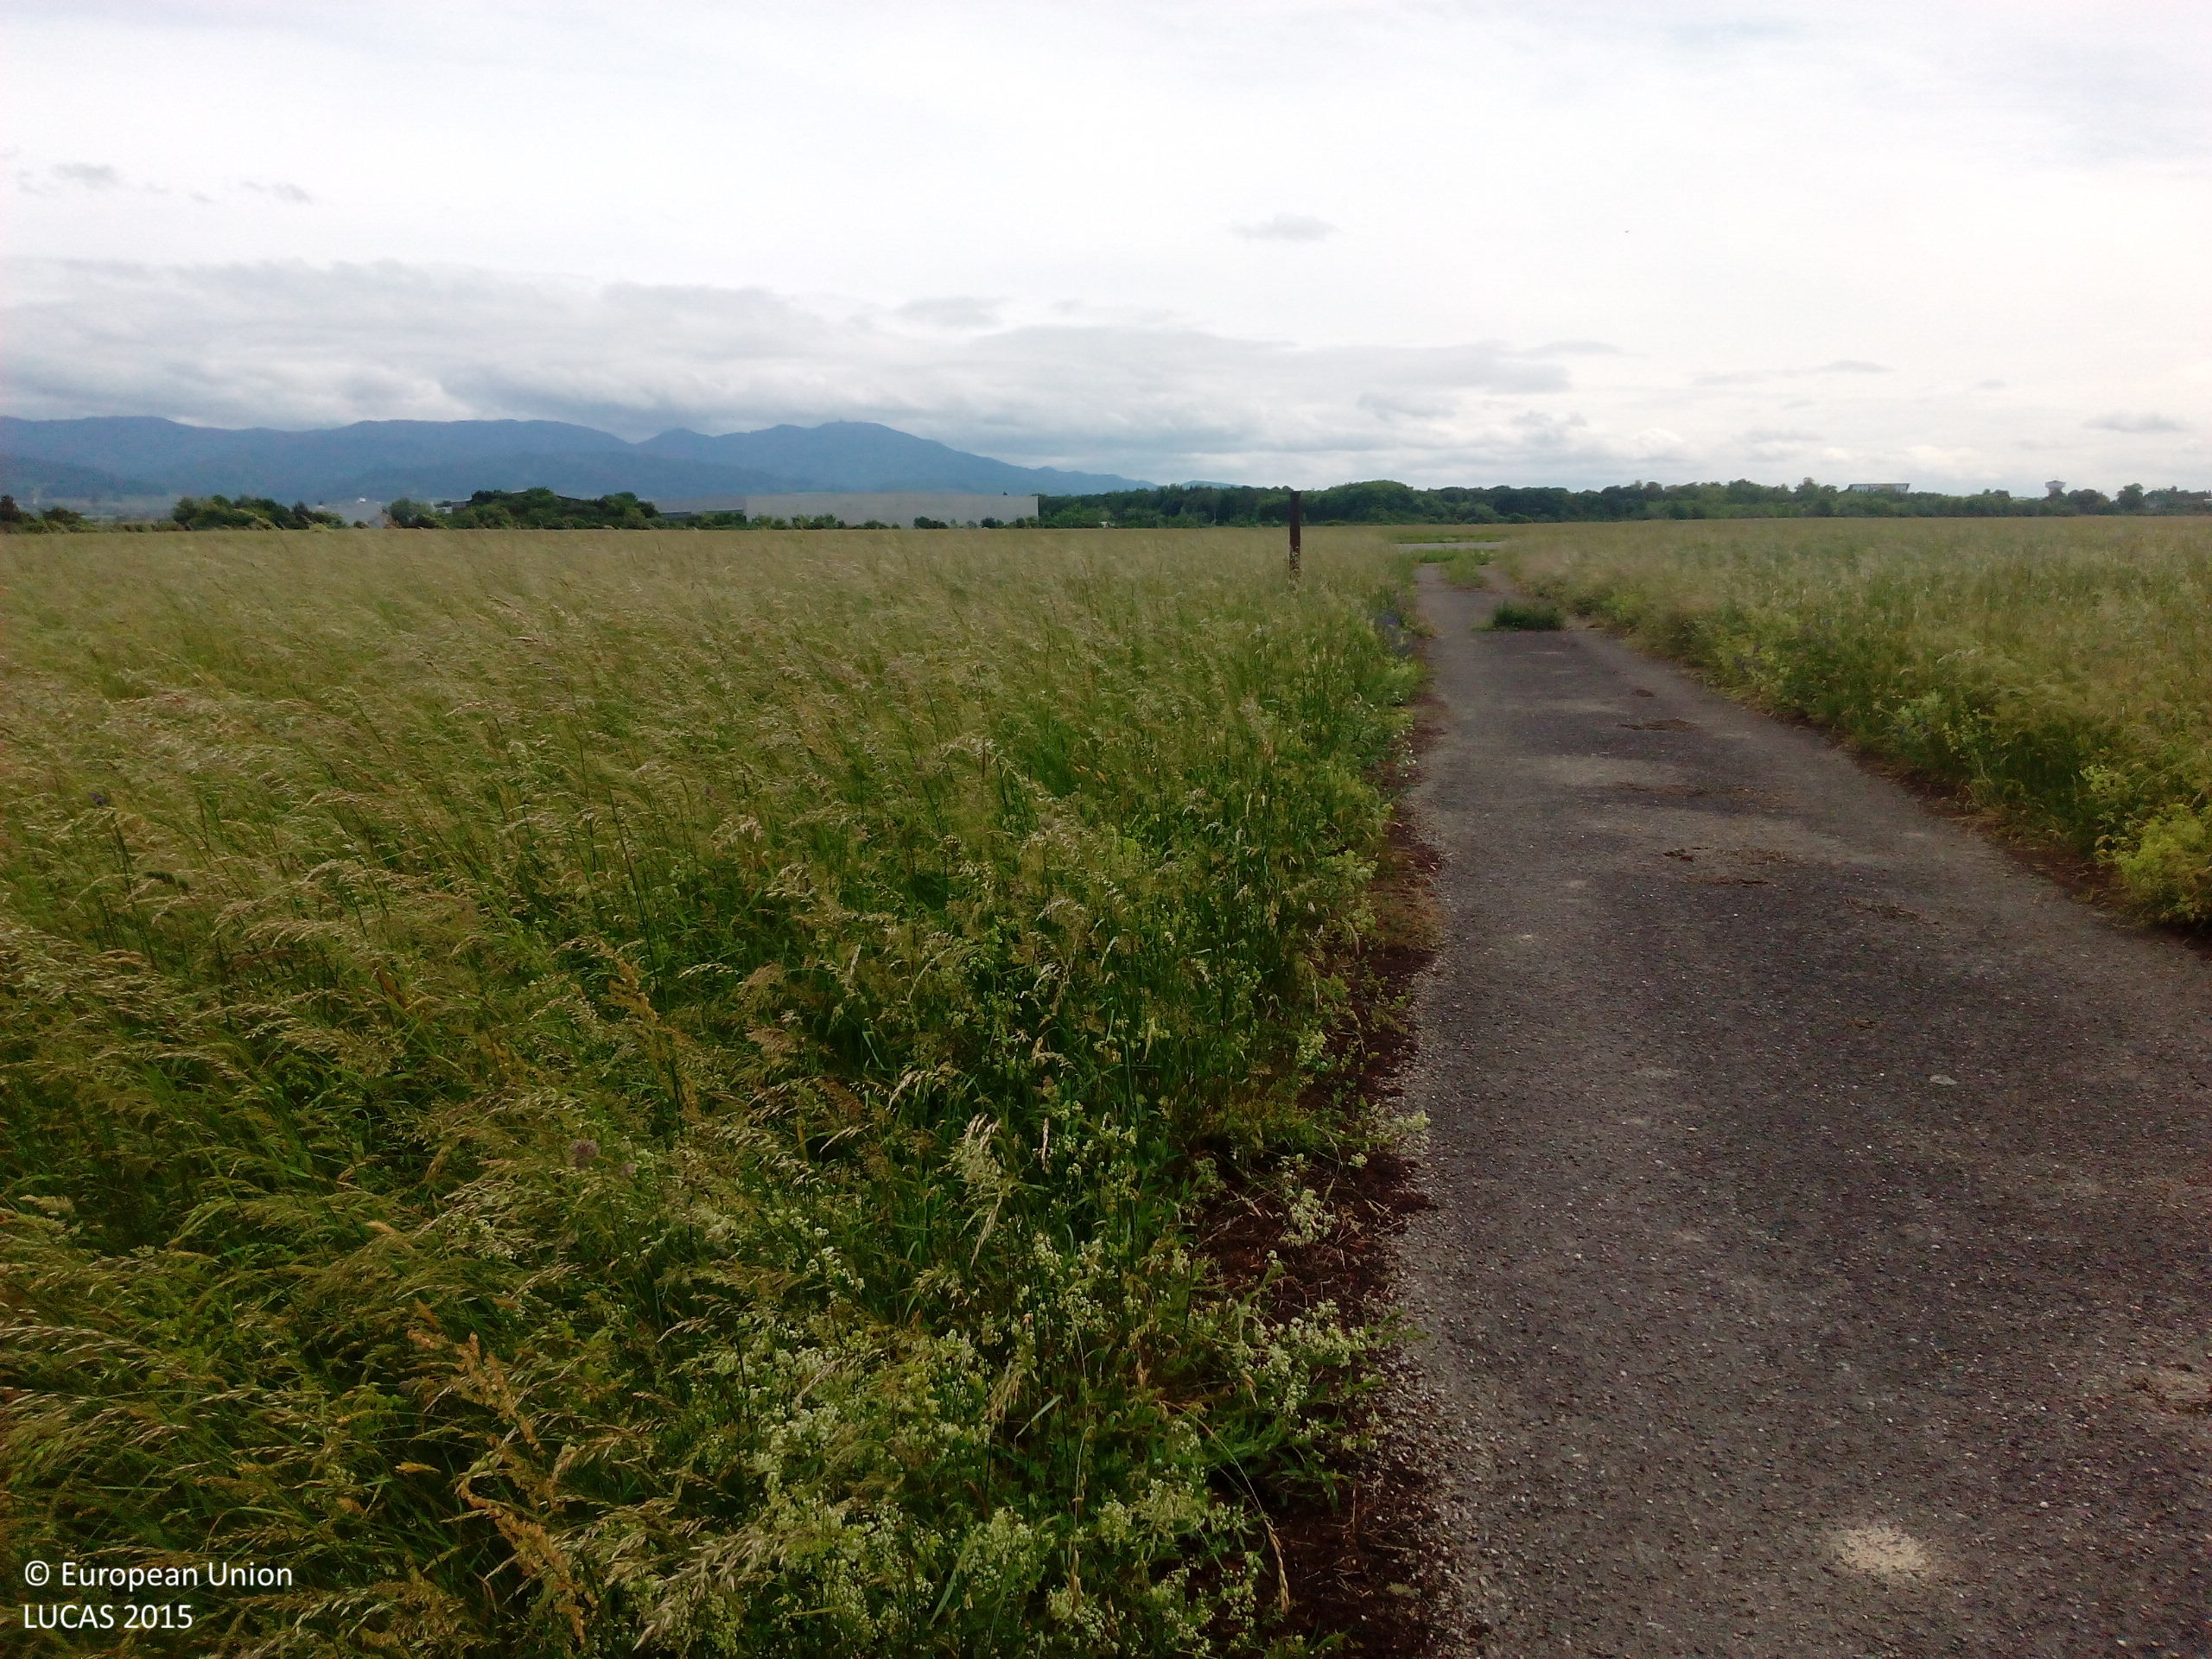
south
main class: Grassland
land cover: Grassland without tree/shrub cover
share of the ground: > 75 %
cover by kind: herbaceous plants 100 %
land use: Air transport
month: May
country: DE
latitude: 47.9101
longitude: 7.6331
